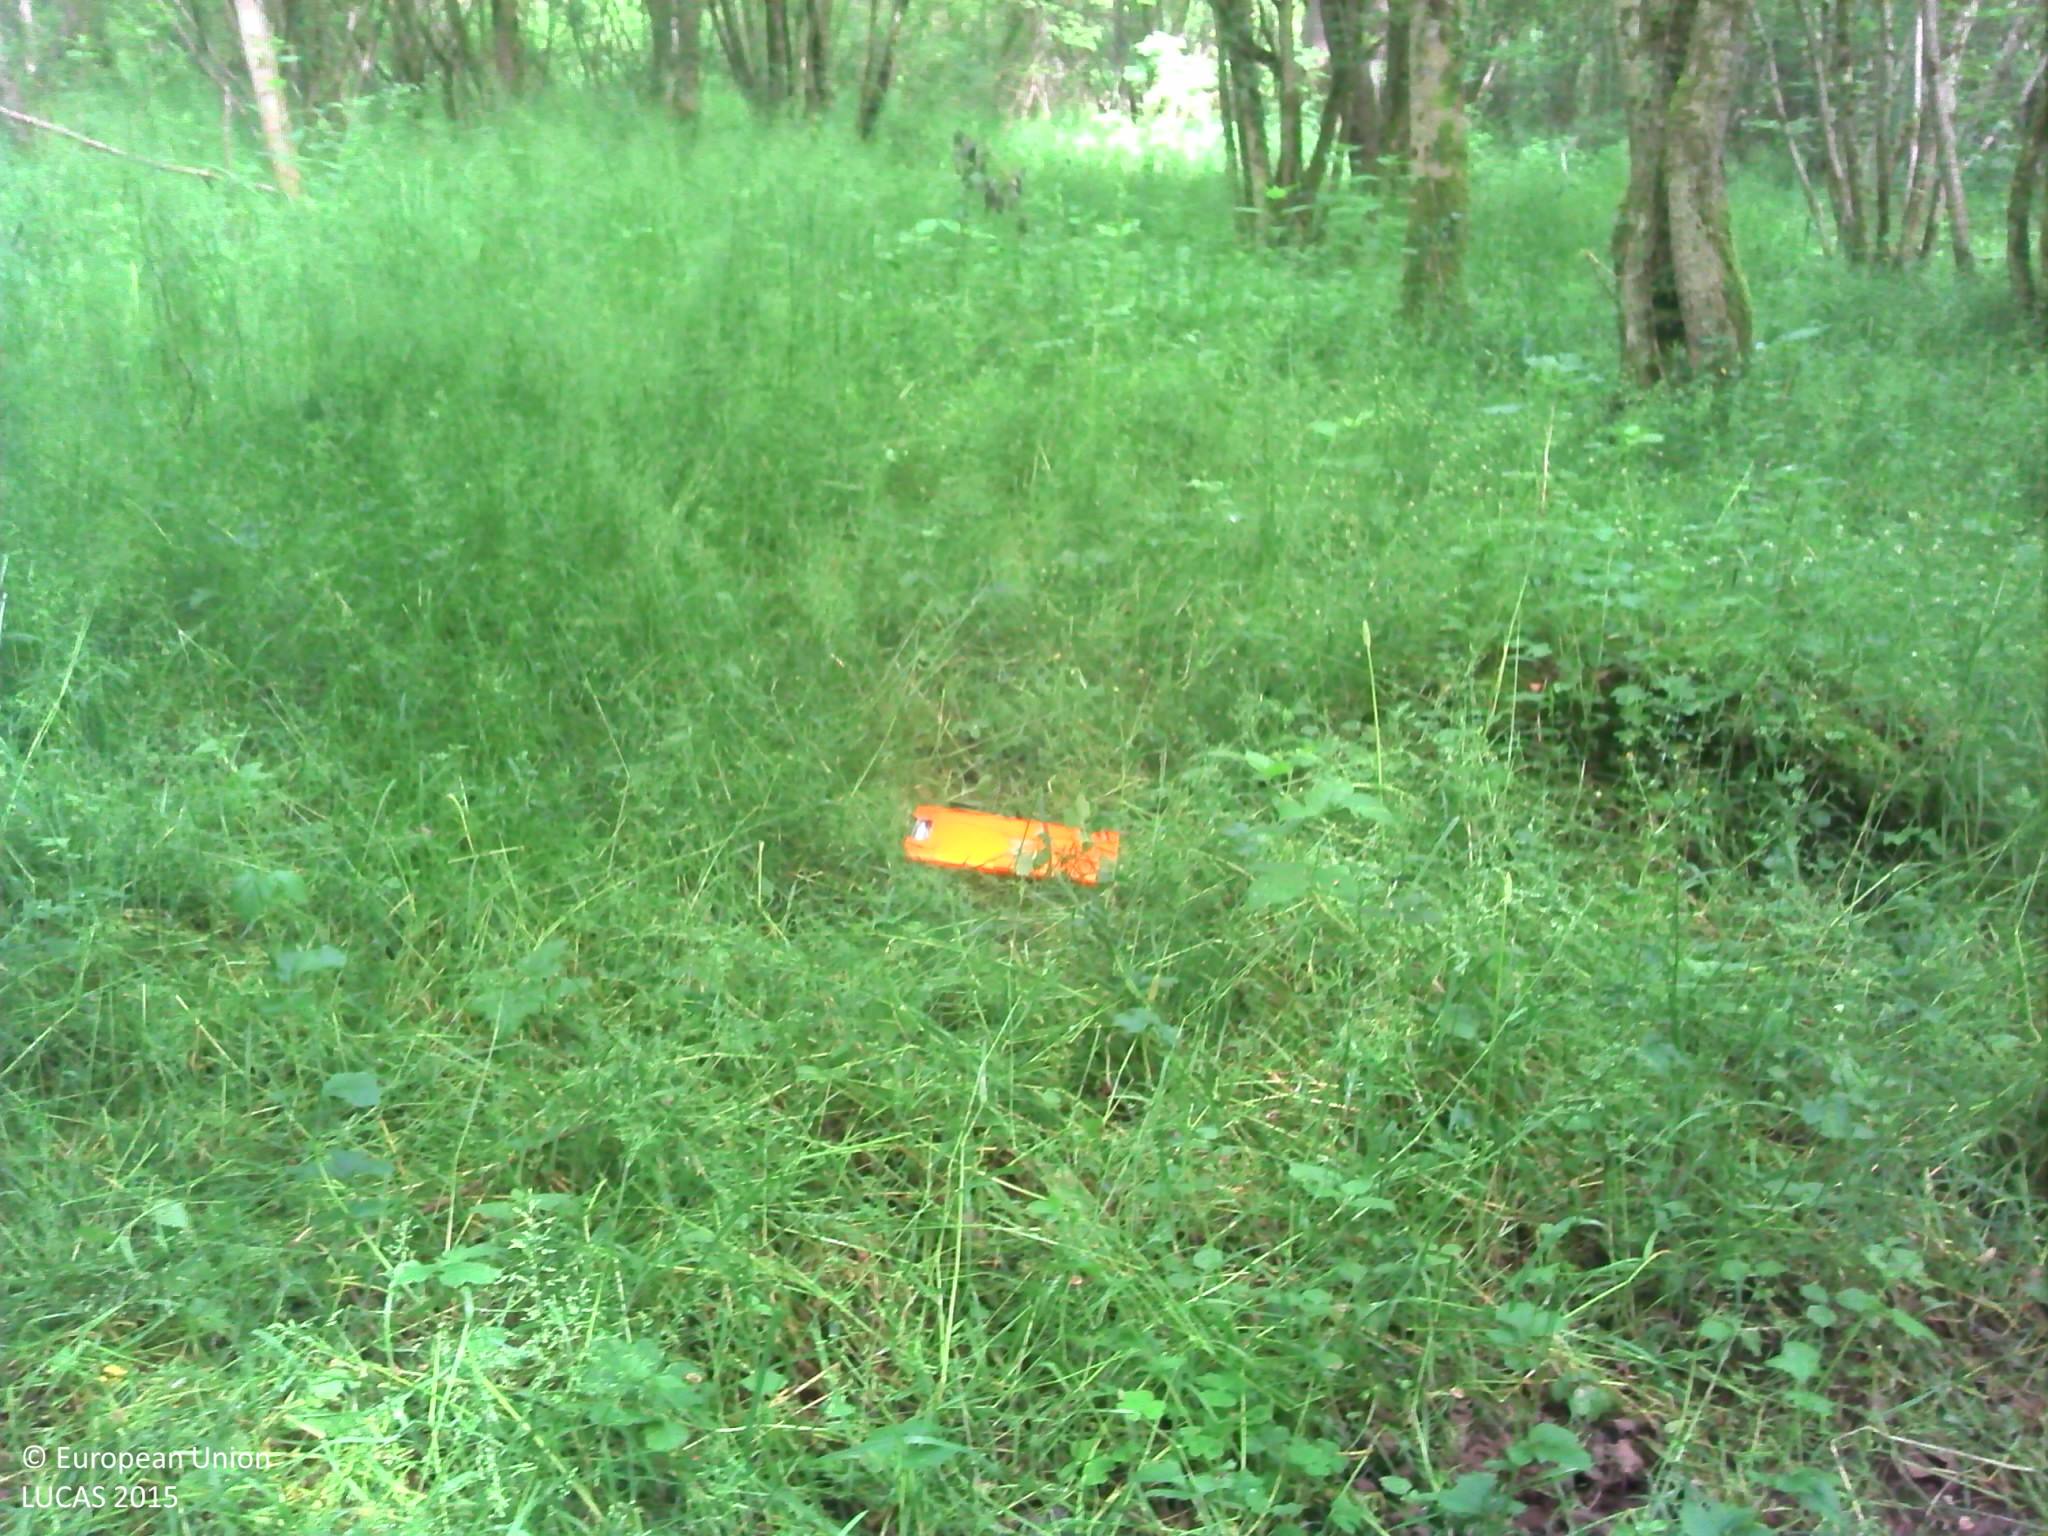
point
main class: Woodland
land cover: Broadleaved woodland
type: mesophytic deciduous forest
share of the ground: > 75 %
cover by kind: broadleaved forest trees 85 %, herbaceous plants 10 %, coniferous forest trees 5 %
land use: Forestry
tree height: > 5 m
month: May
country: FR
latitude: 48.6660
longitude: 4.9334
